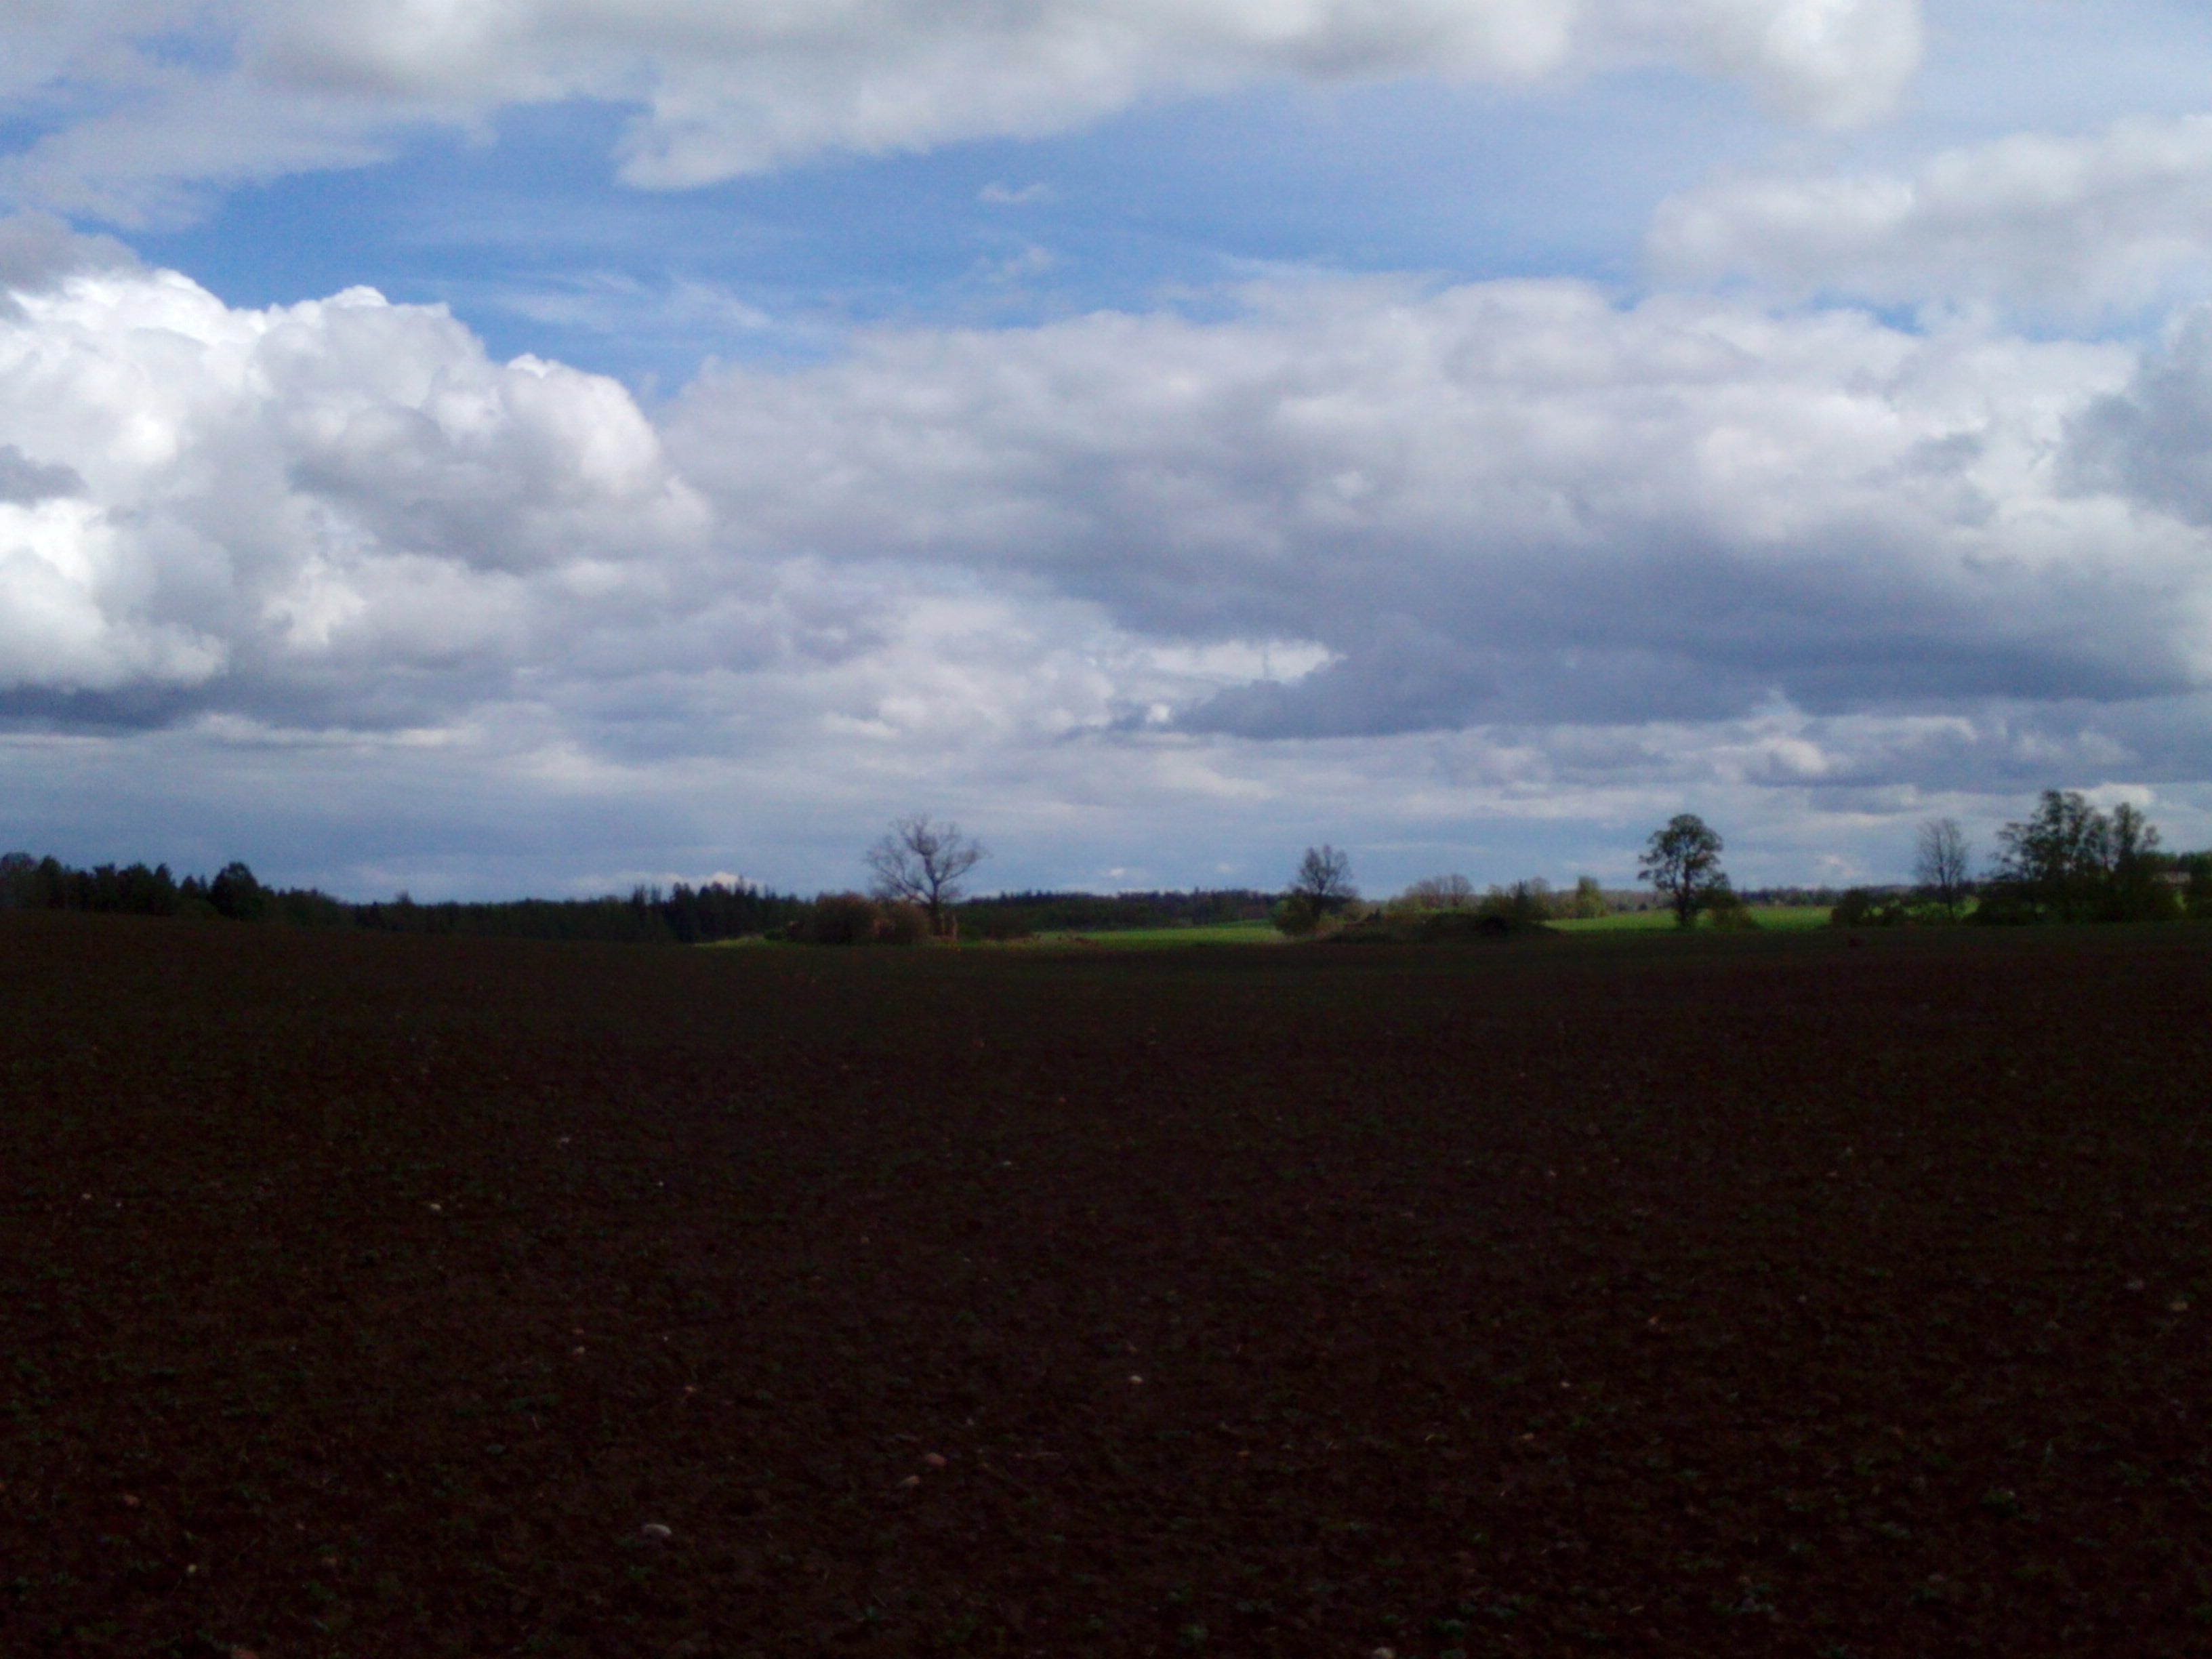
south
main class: Cropland
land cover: Dry pulses
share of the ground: 10 - 25 %
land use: Agriculture (excluding fallow land and kitchen gardens)
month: May
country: LV
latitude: 56.7581
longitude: 22.8697
